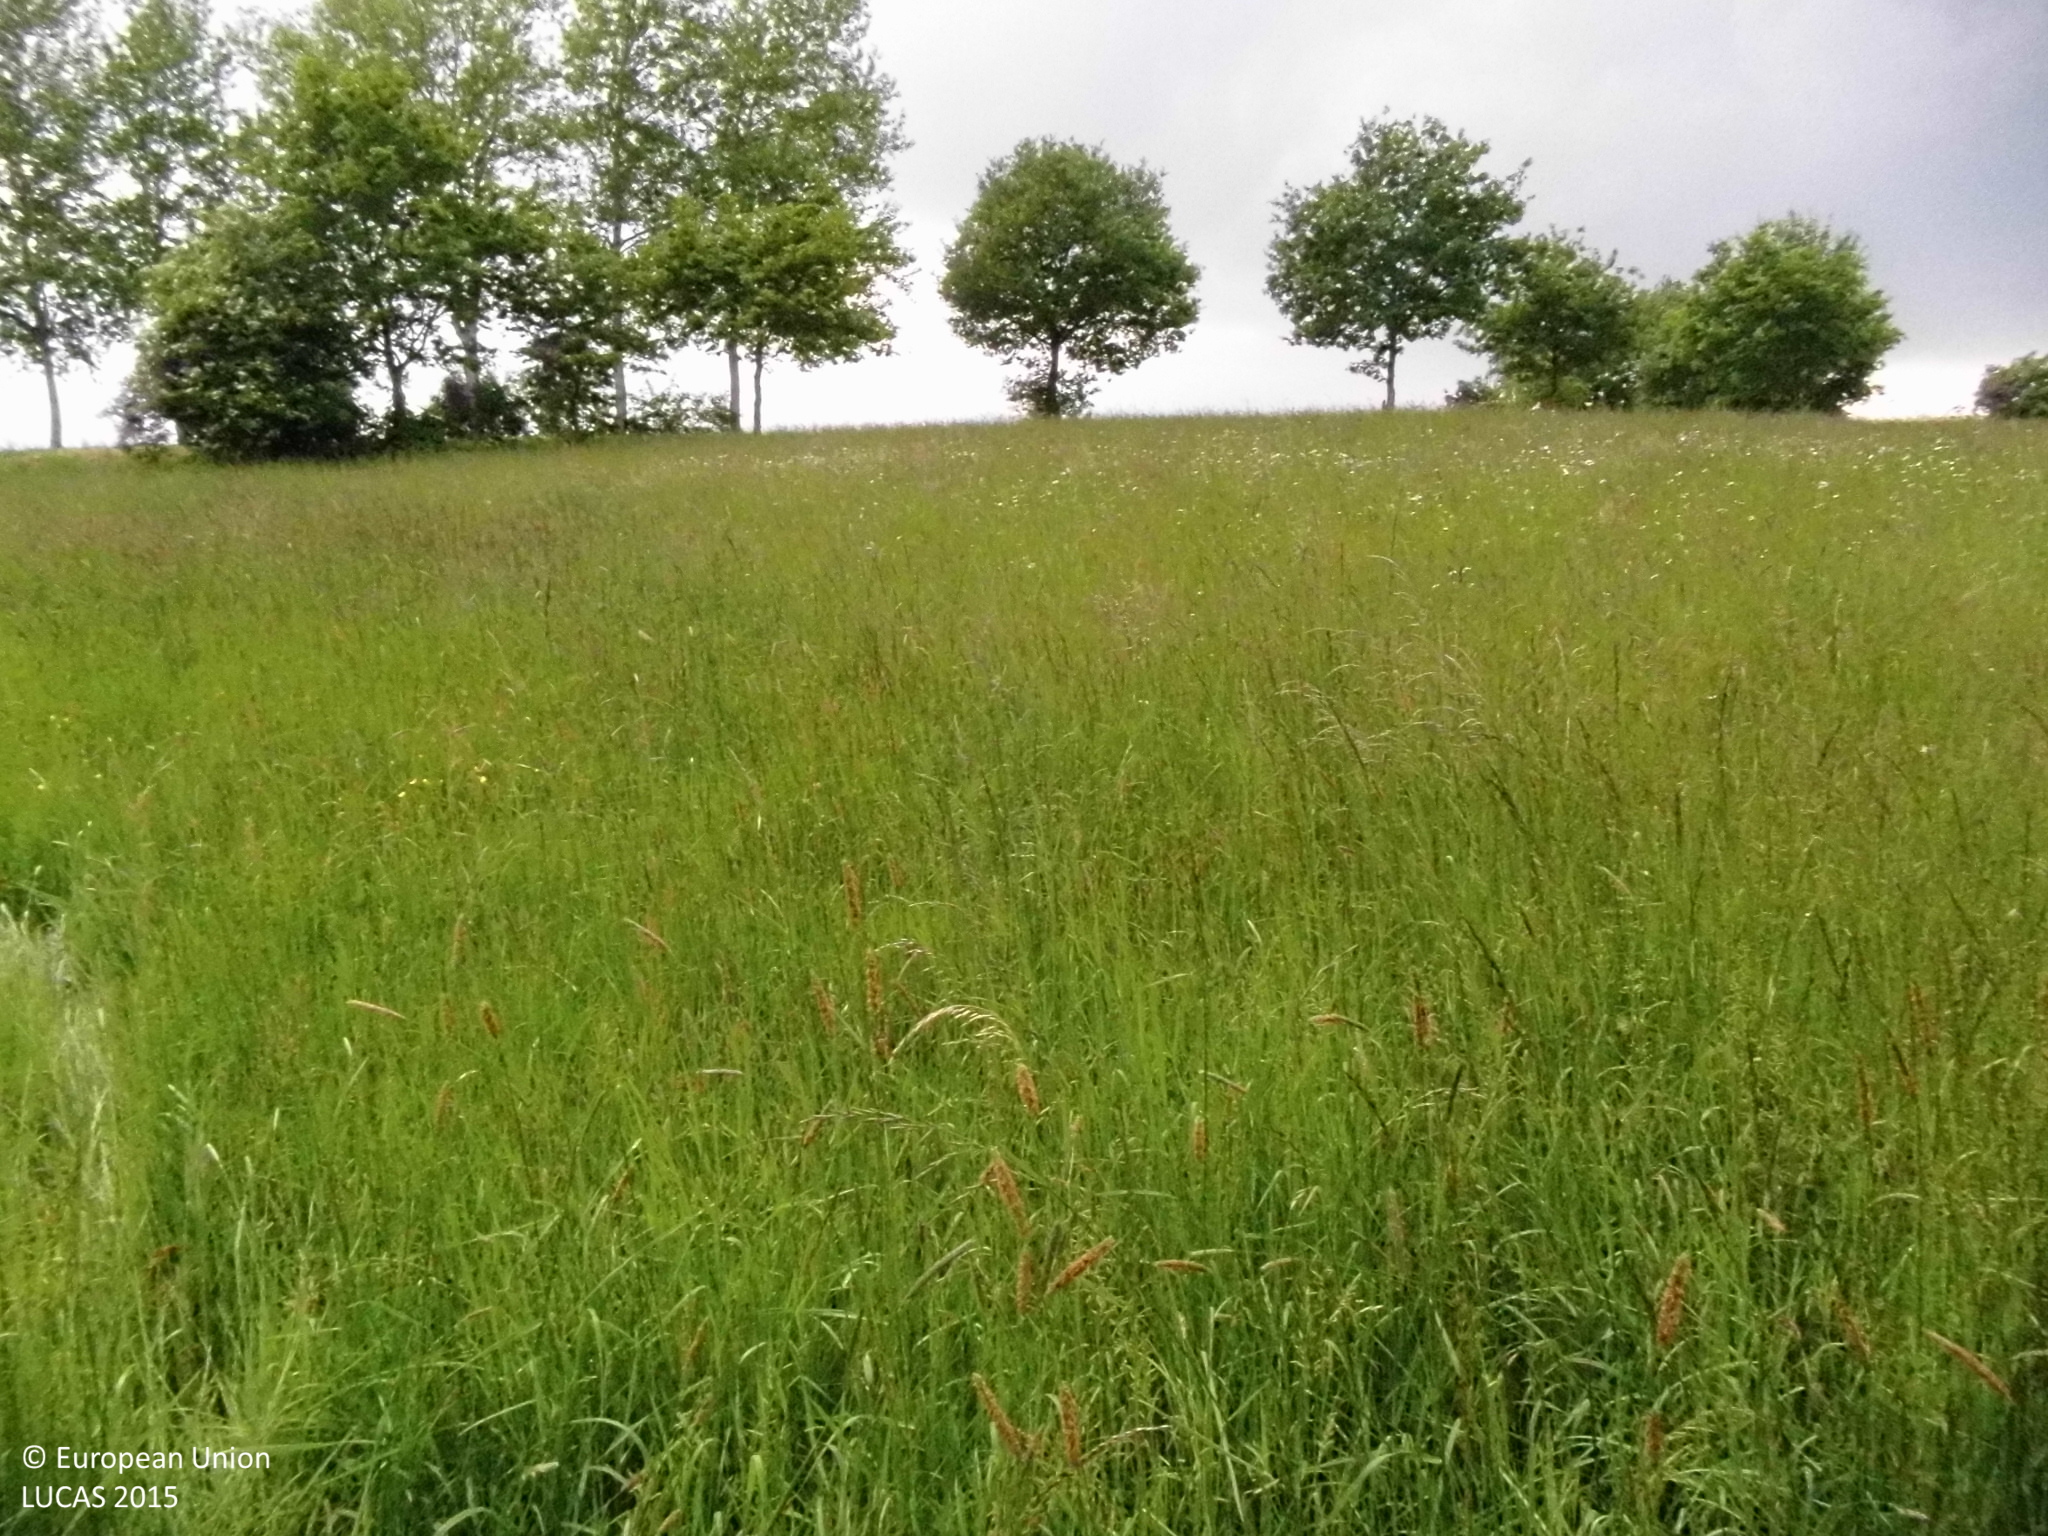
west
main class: Grassland
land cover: Grassland without tree/shrub cover
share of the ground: > 75 %
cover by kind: herbaceous plants 100 %
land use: Agriculture (excluding fallow land and kitchen gardens)
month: May
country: DE
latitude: 50.7131
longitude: 7.4368
